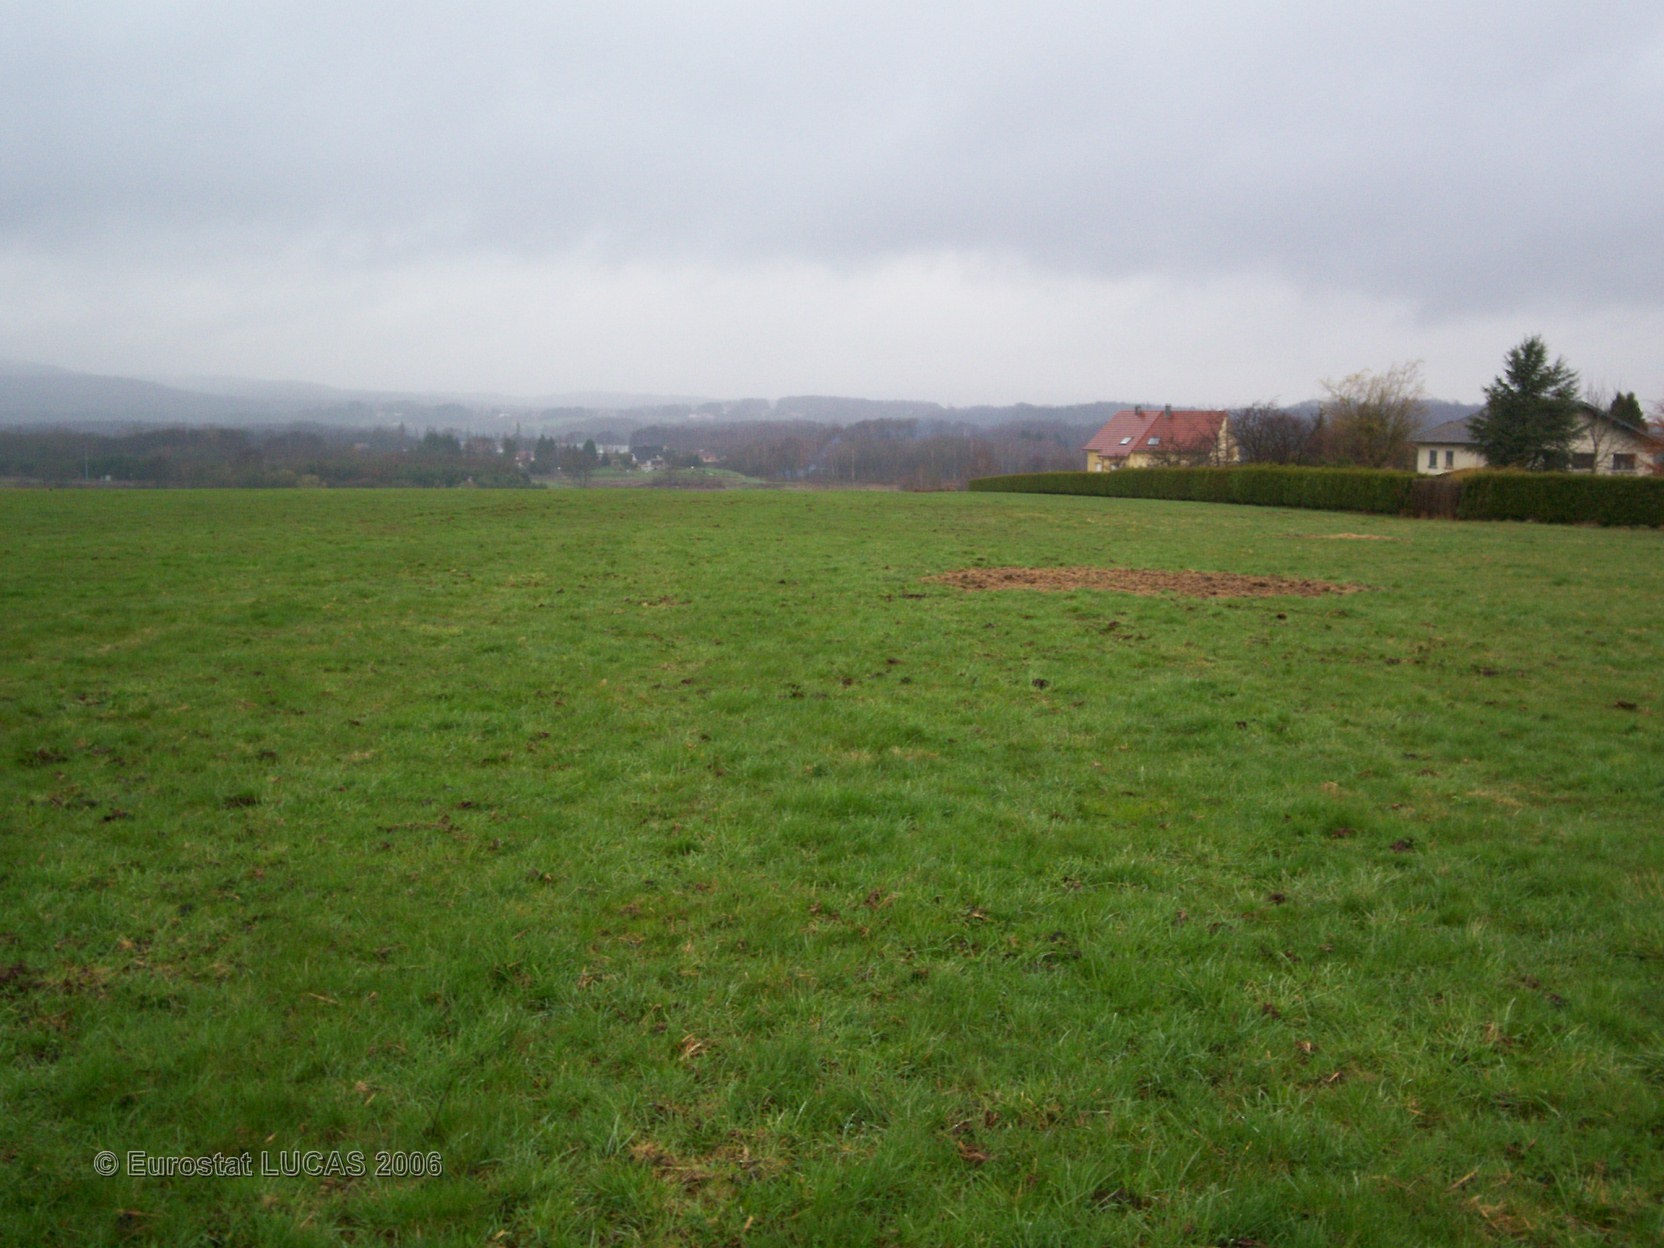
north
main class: Grassland
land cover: Grassland without tree/shrub cover
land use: Agriculture (excluding fallow land and kitchen gardens)
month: April
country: FR
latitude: 47.6734
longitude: 6.8183
